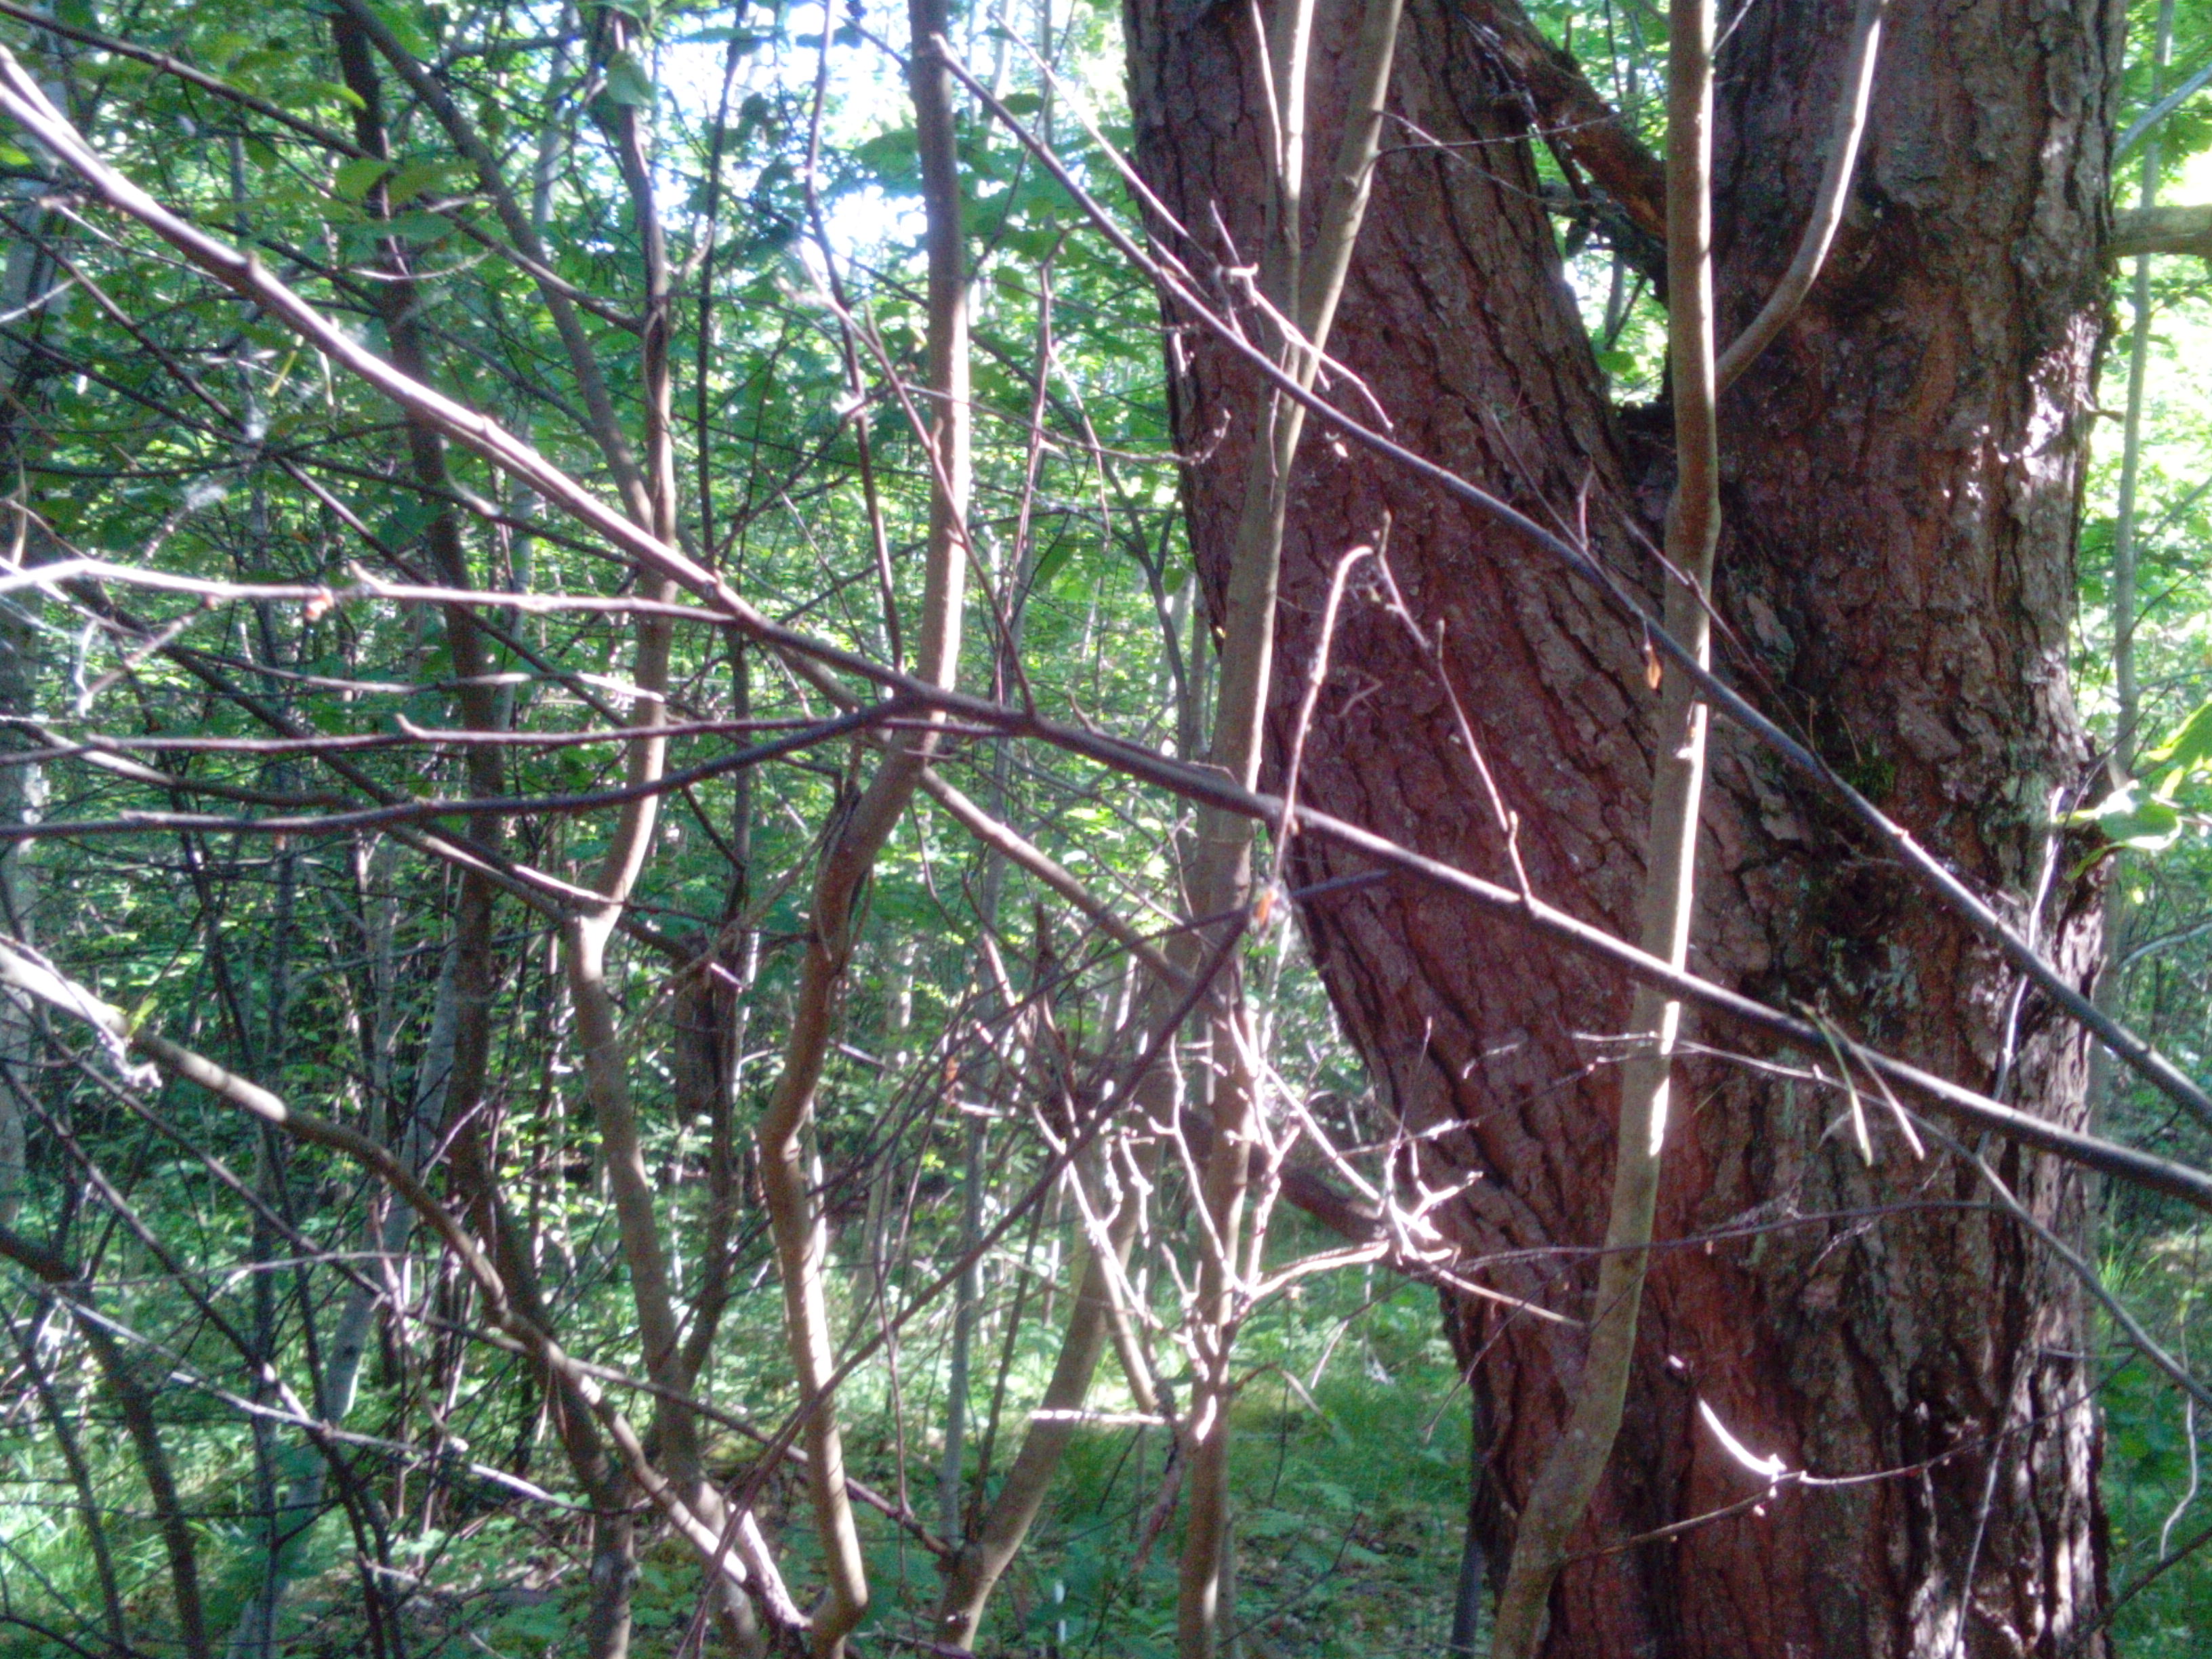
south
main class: Woodland
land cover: Pine dominated mixed woodland
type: hemiboreal forest and nemoral coniferous forest and mixed broadleaved-coniferous forest
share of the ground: > 75 %
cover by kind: broadleaved forest trees 65 %, coniferous forest trees 30 %, shrubs 5 %
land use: Forestry
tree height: > 5 m
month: June
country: LV
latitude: 56.8238
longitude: 22.1925
